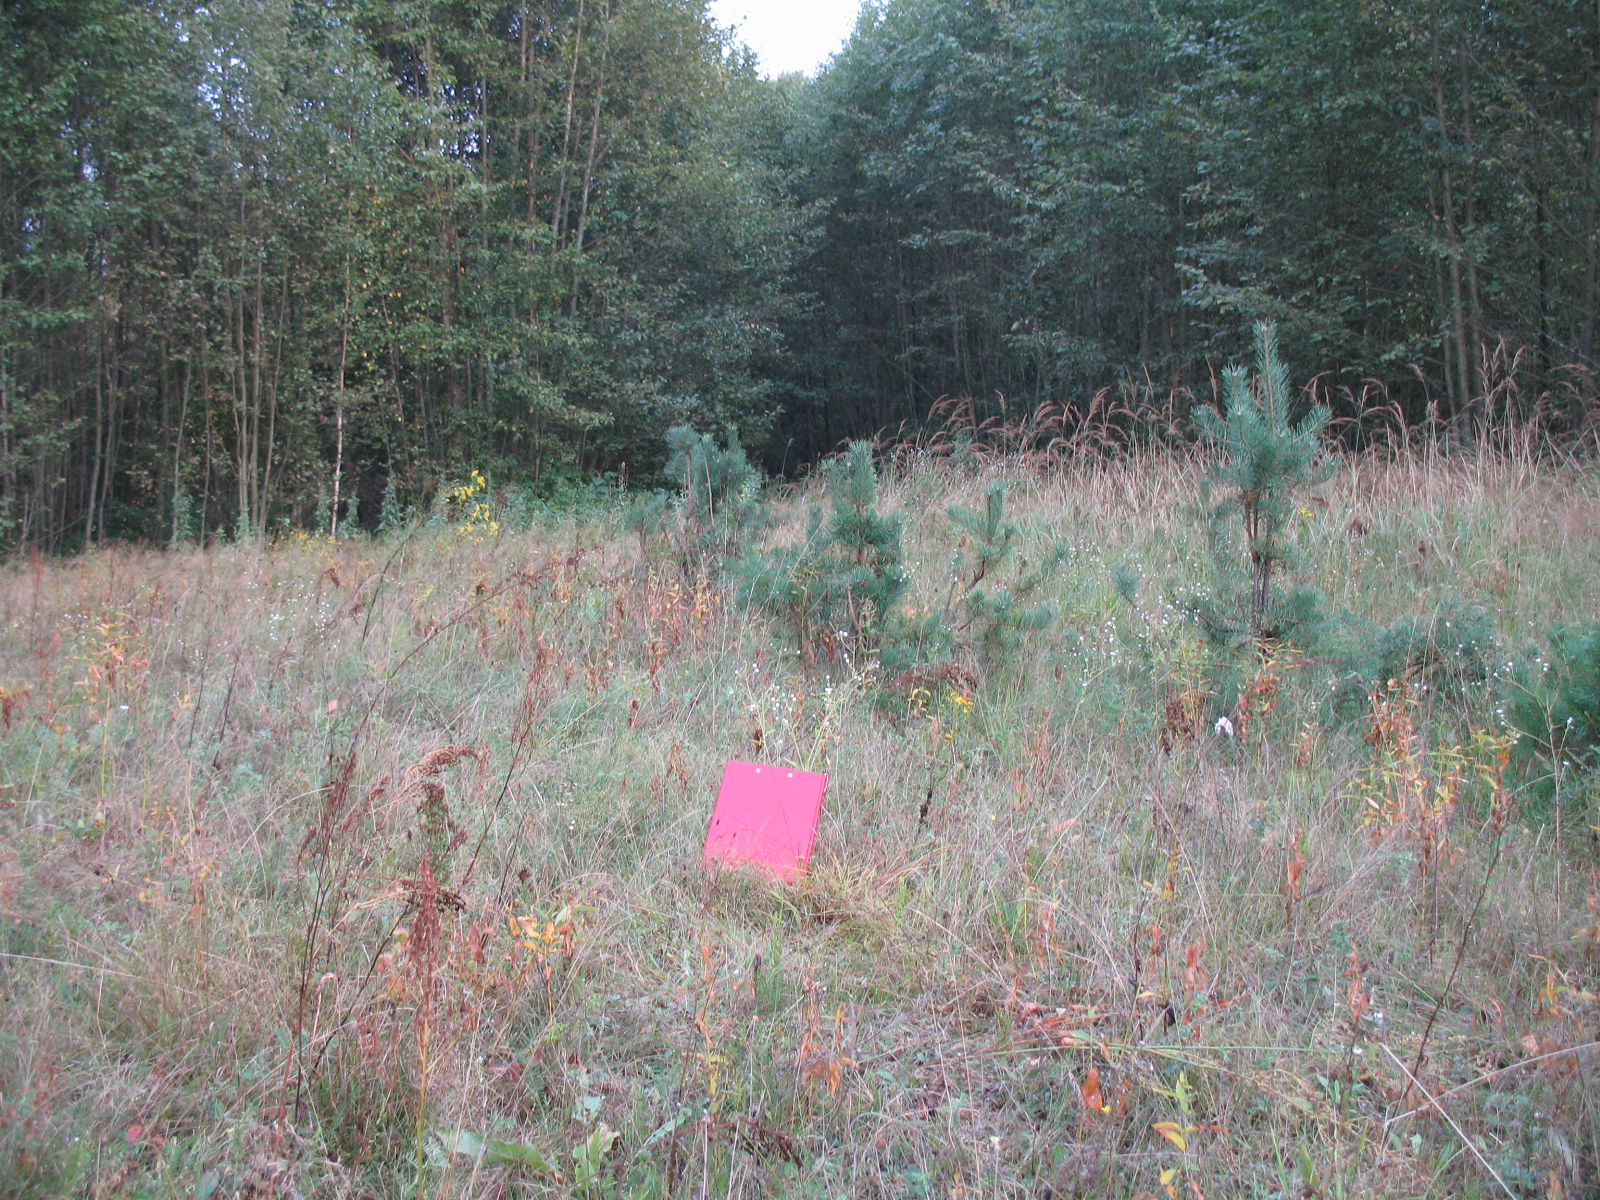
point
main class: Grassland
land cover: Grassland with sparse tree/shrub cover
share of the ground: > 75 %
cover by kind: herbaceous plants 95 %, coniferous forest trees 5 %
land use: Forestry
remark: Nursery
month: September
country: LV
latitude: 56.1520
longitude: 26.2565
